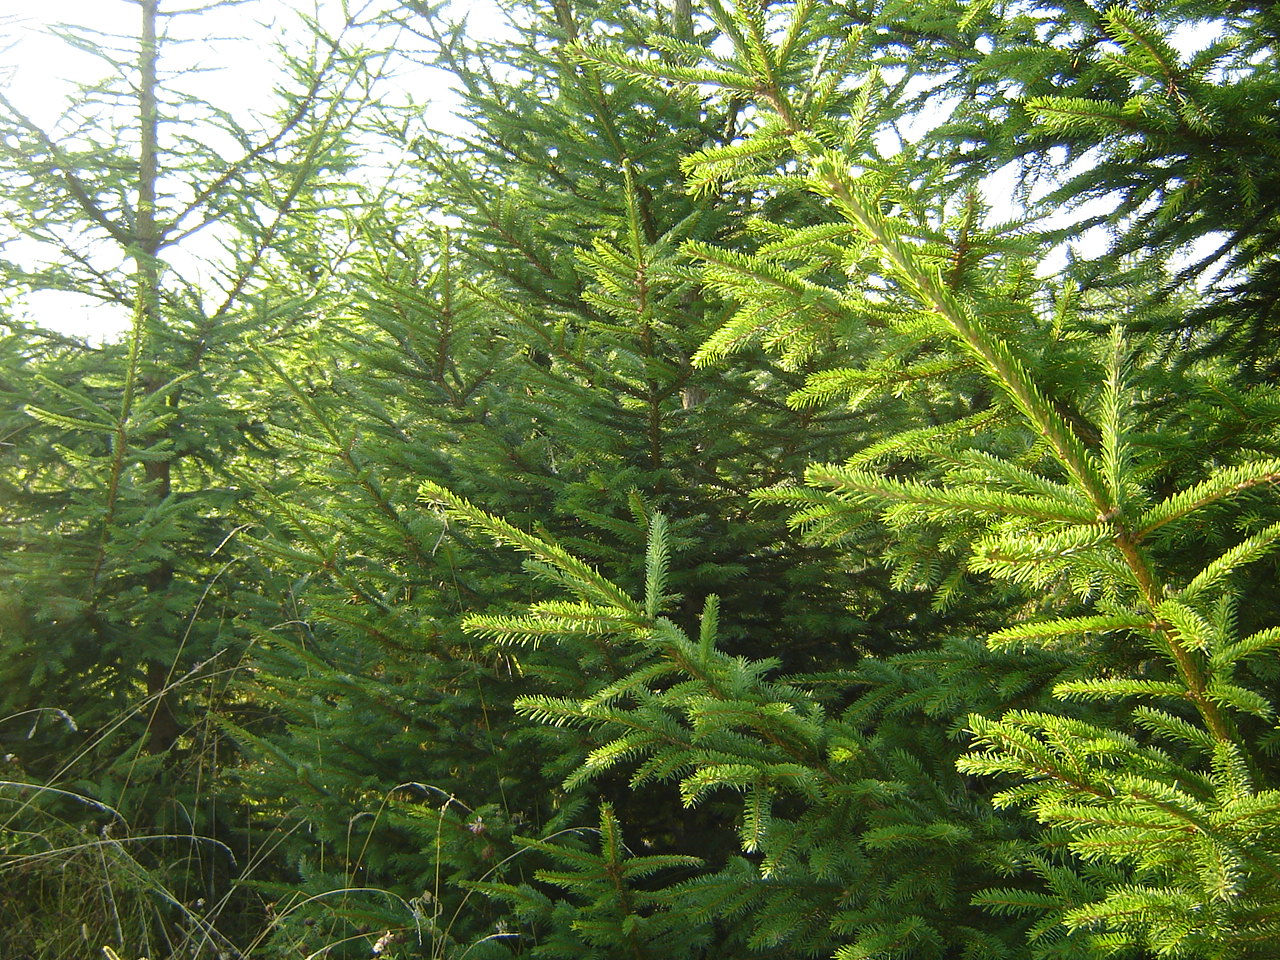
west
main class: Woodland
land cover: Spruce dominated coniferous woodland
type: hemiboreal forest and nemoral coniferous forest and mixed broadleaved-coniferous forest
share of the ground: > 75 %
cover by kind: coniferous forest trees 75 %, broadleaved forest trees 15 %, herbaceous plants 10 %
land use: Forestry
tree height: < 5 m
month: August
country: LT
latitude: 55.2014
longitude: 24.8952
